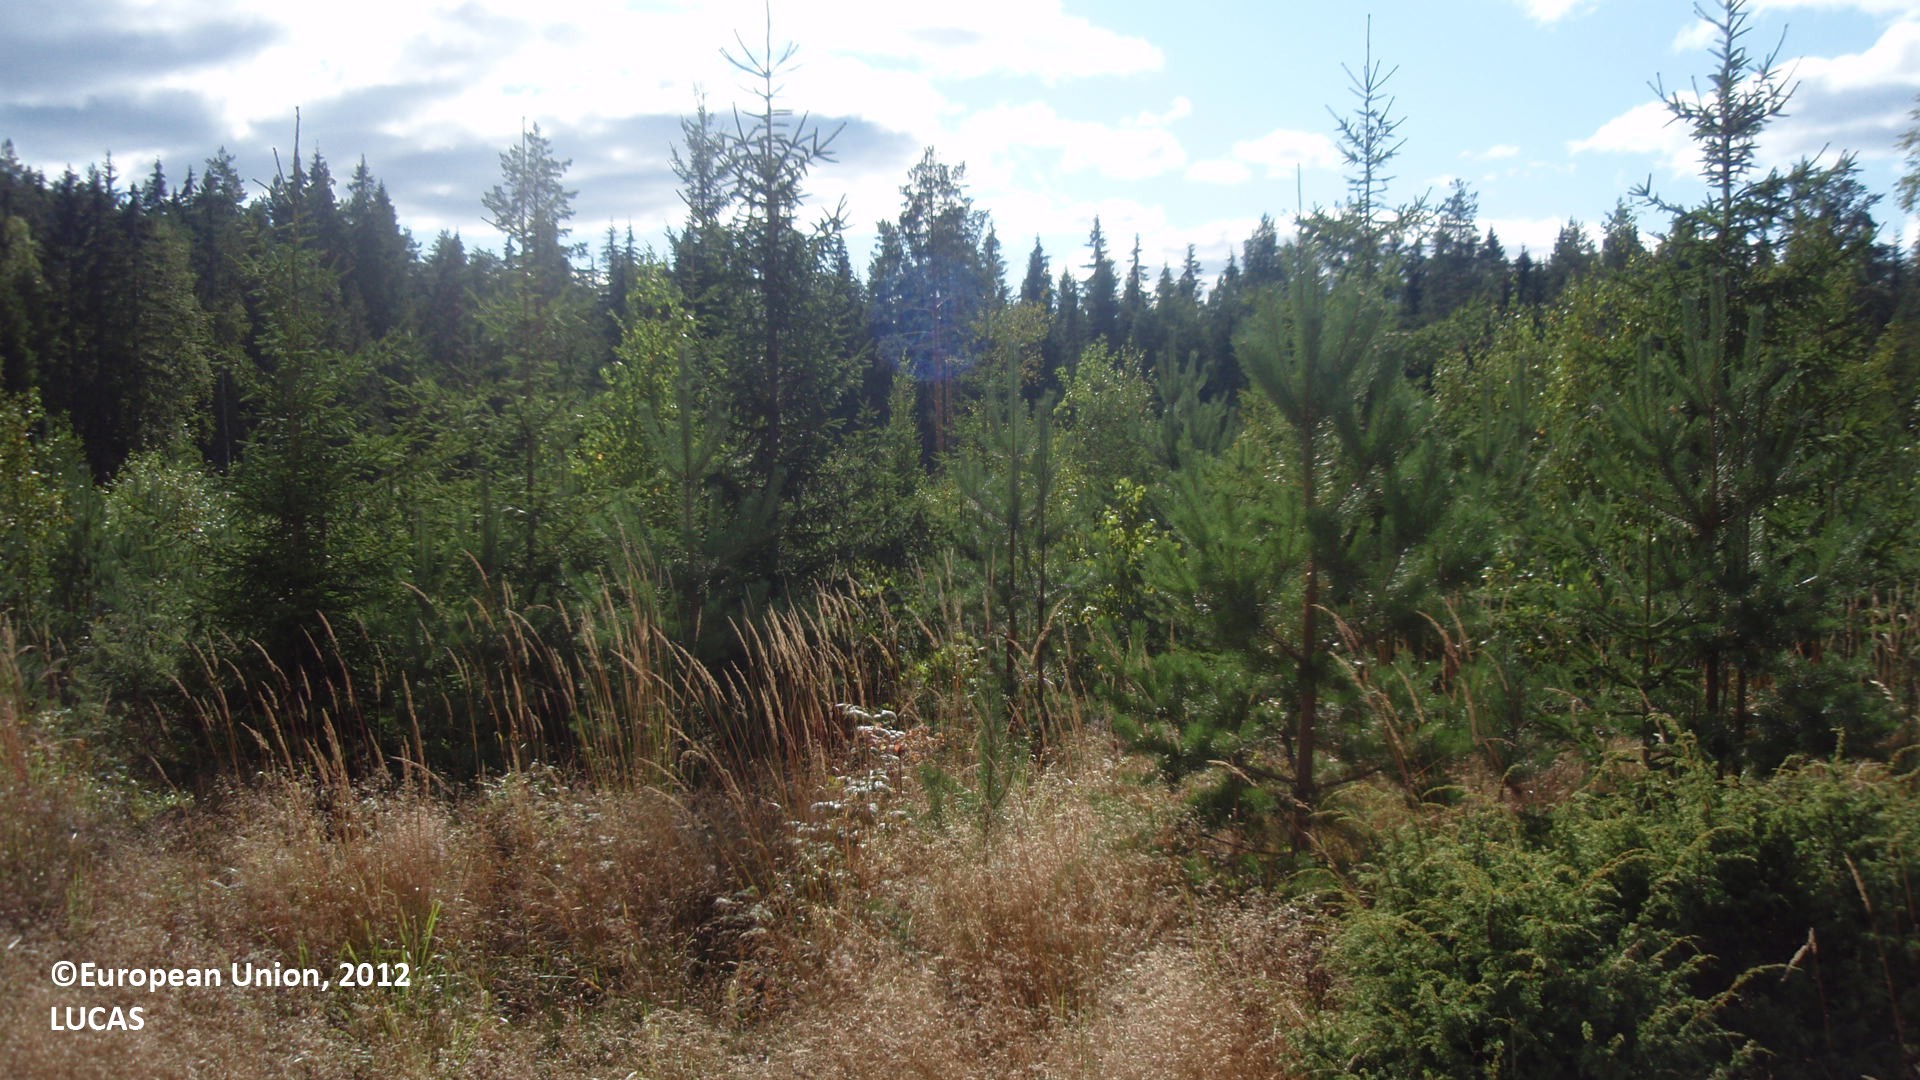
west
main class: Grassland
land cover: Grassland with sparse tree/shrub cover
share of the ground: 50 - 75 %
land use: Forestry
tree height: > 5 m
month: August
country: FI
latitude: 60.7246
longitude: 27.4712
